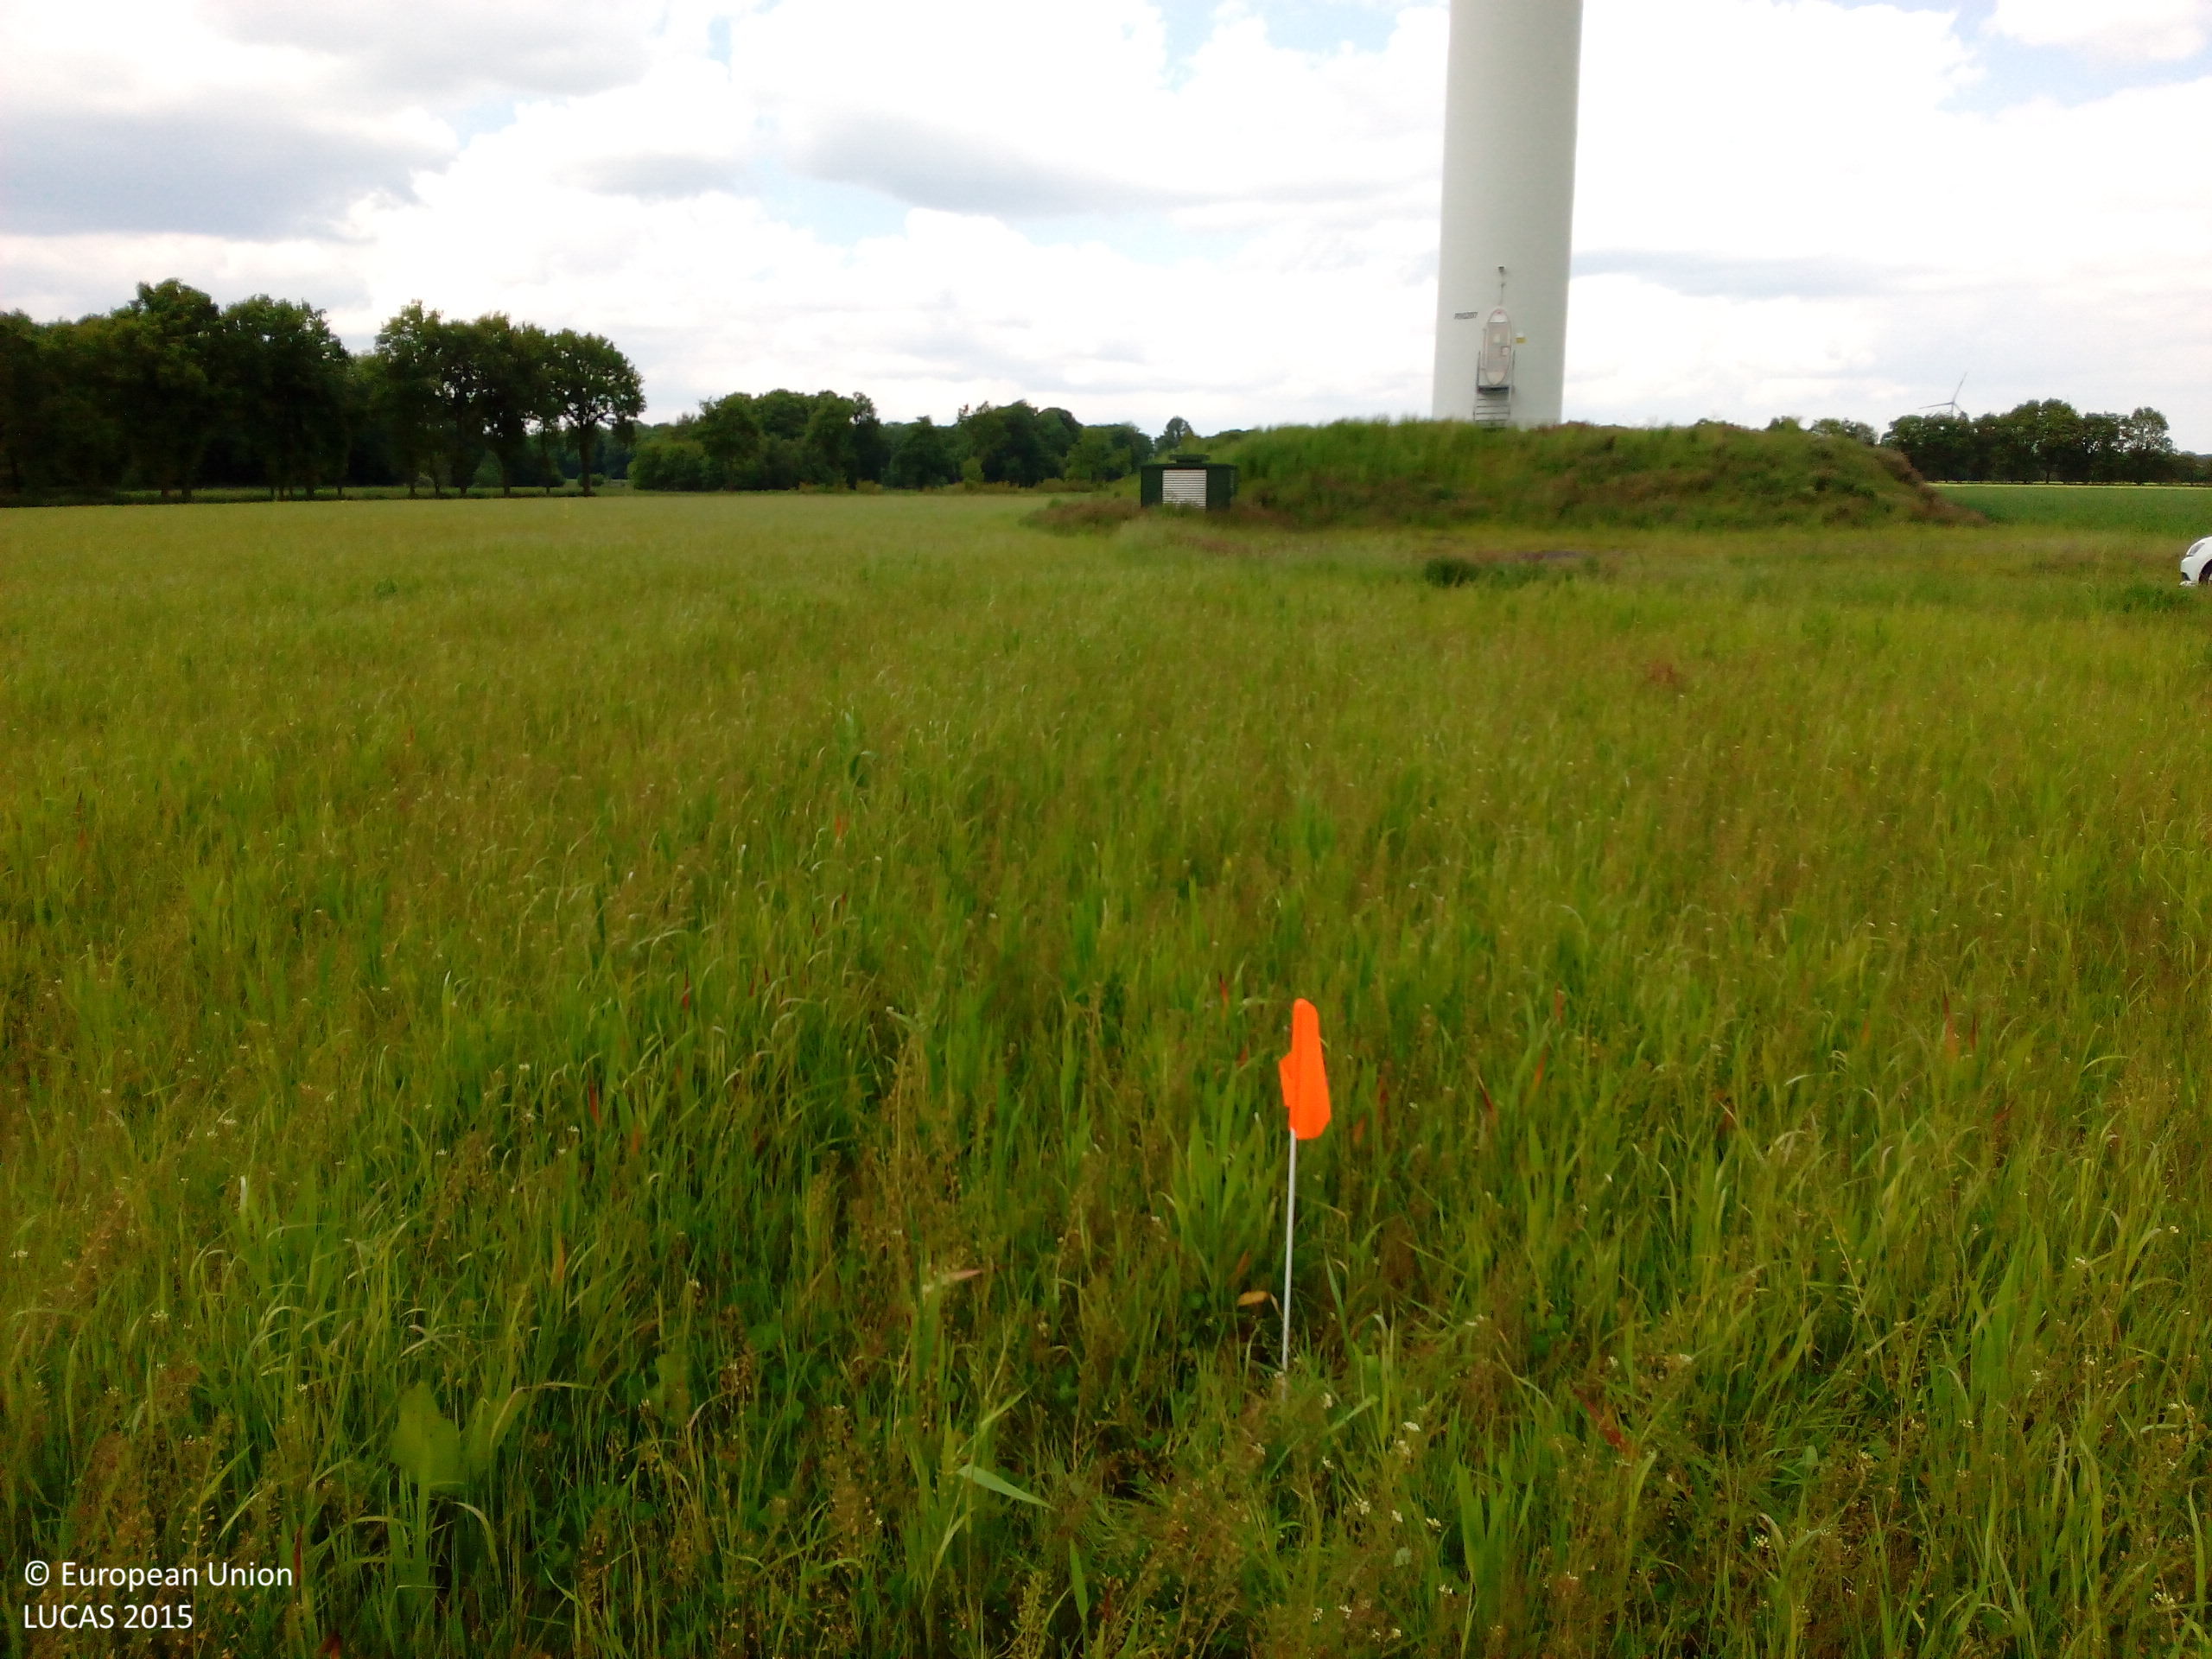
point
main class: Cropland
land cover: Mixed cereals for fodder
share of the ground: > 75 %
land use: Agriculture (excluding fallow land and kitchen gardens)
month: May
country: DE
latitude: 52.1868
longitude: 7.3821
